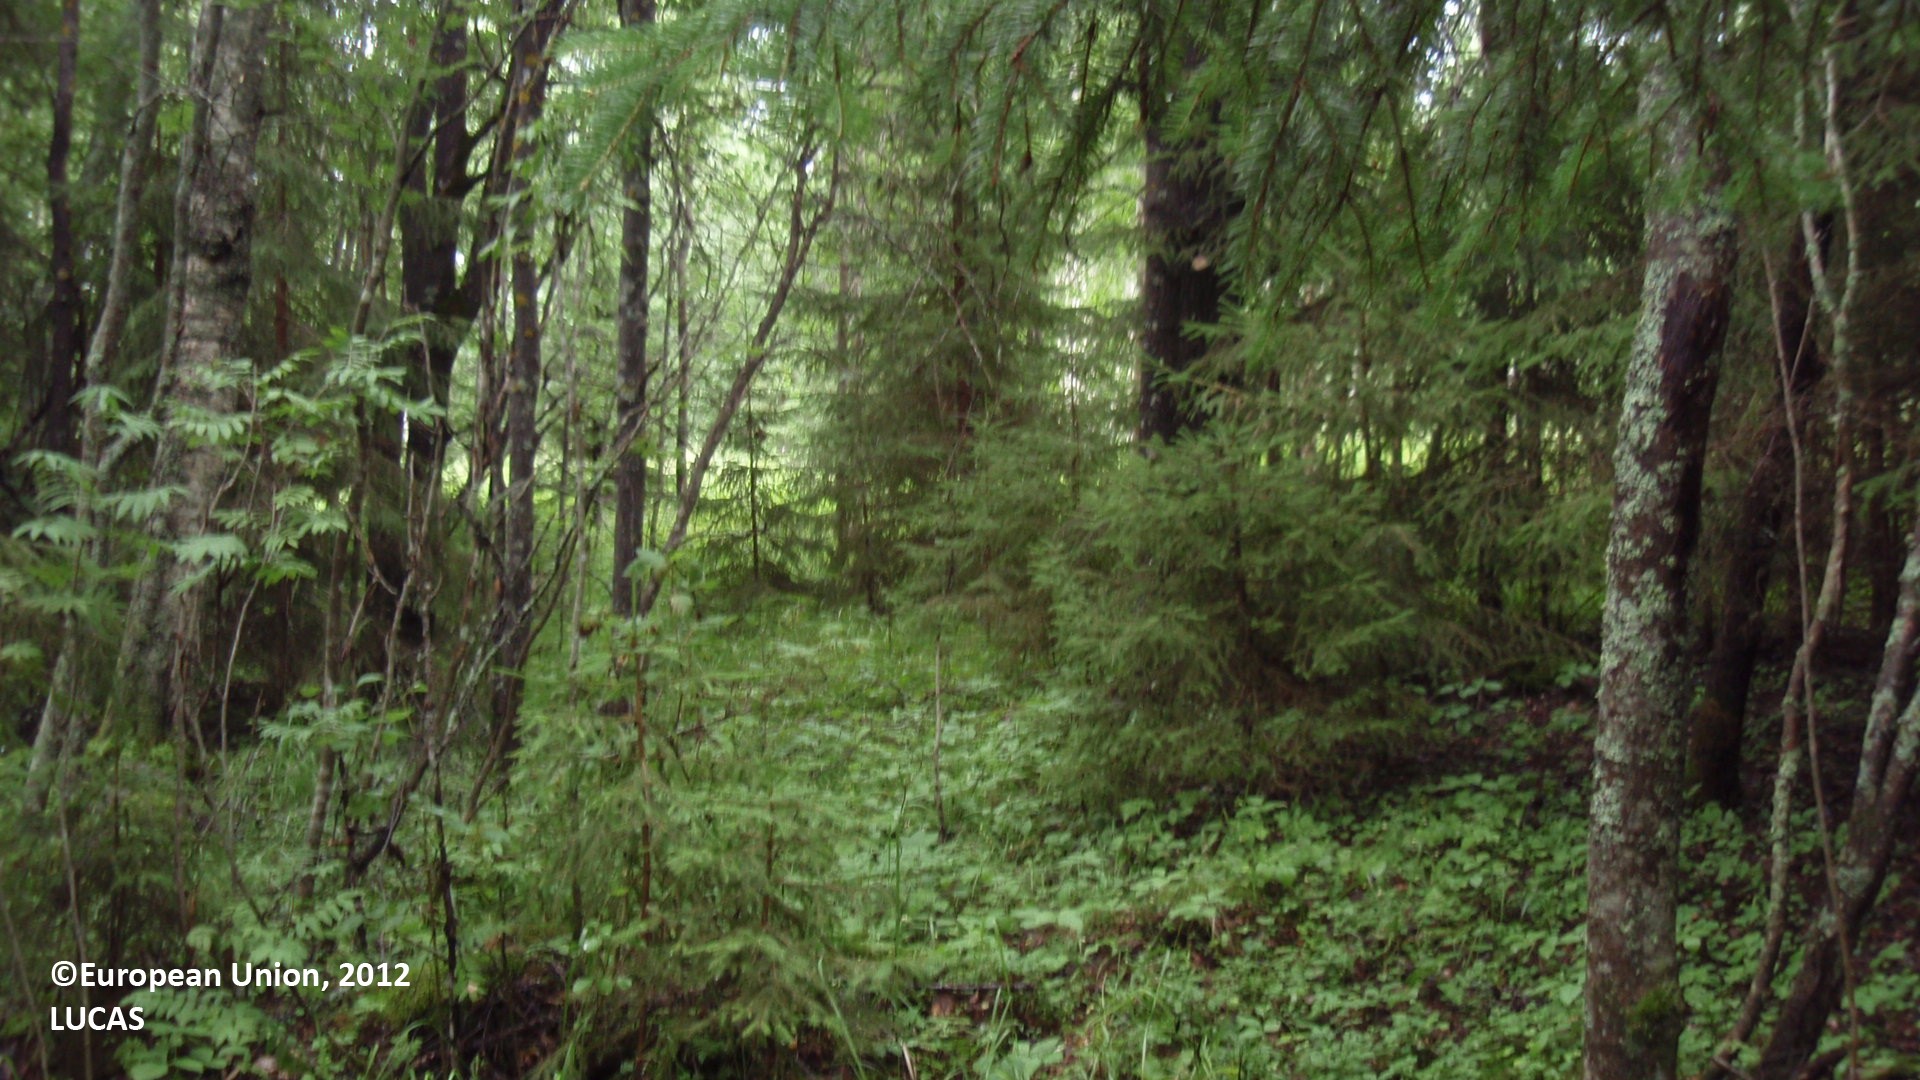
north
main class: Woodland
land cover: Pine dominated mixed woodland
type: boreal forest
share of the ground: 50 - 75 %
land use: Forestry
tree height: > 5 m
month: July
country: FI
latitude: 61.5545
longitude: 26.8888
